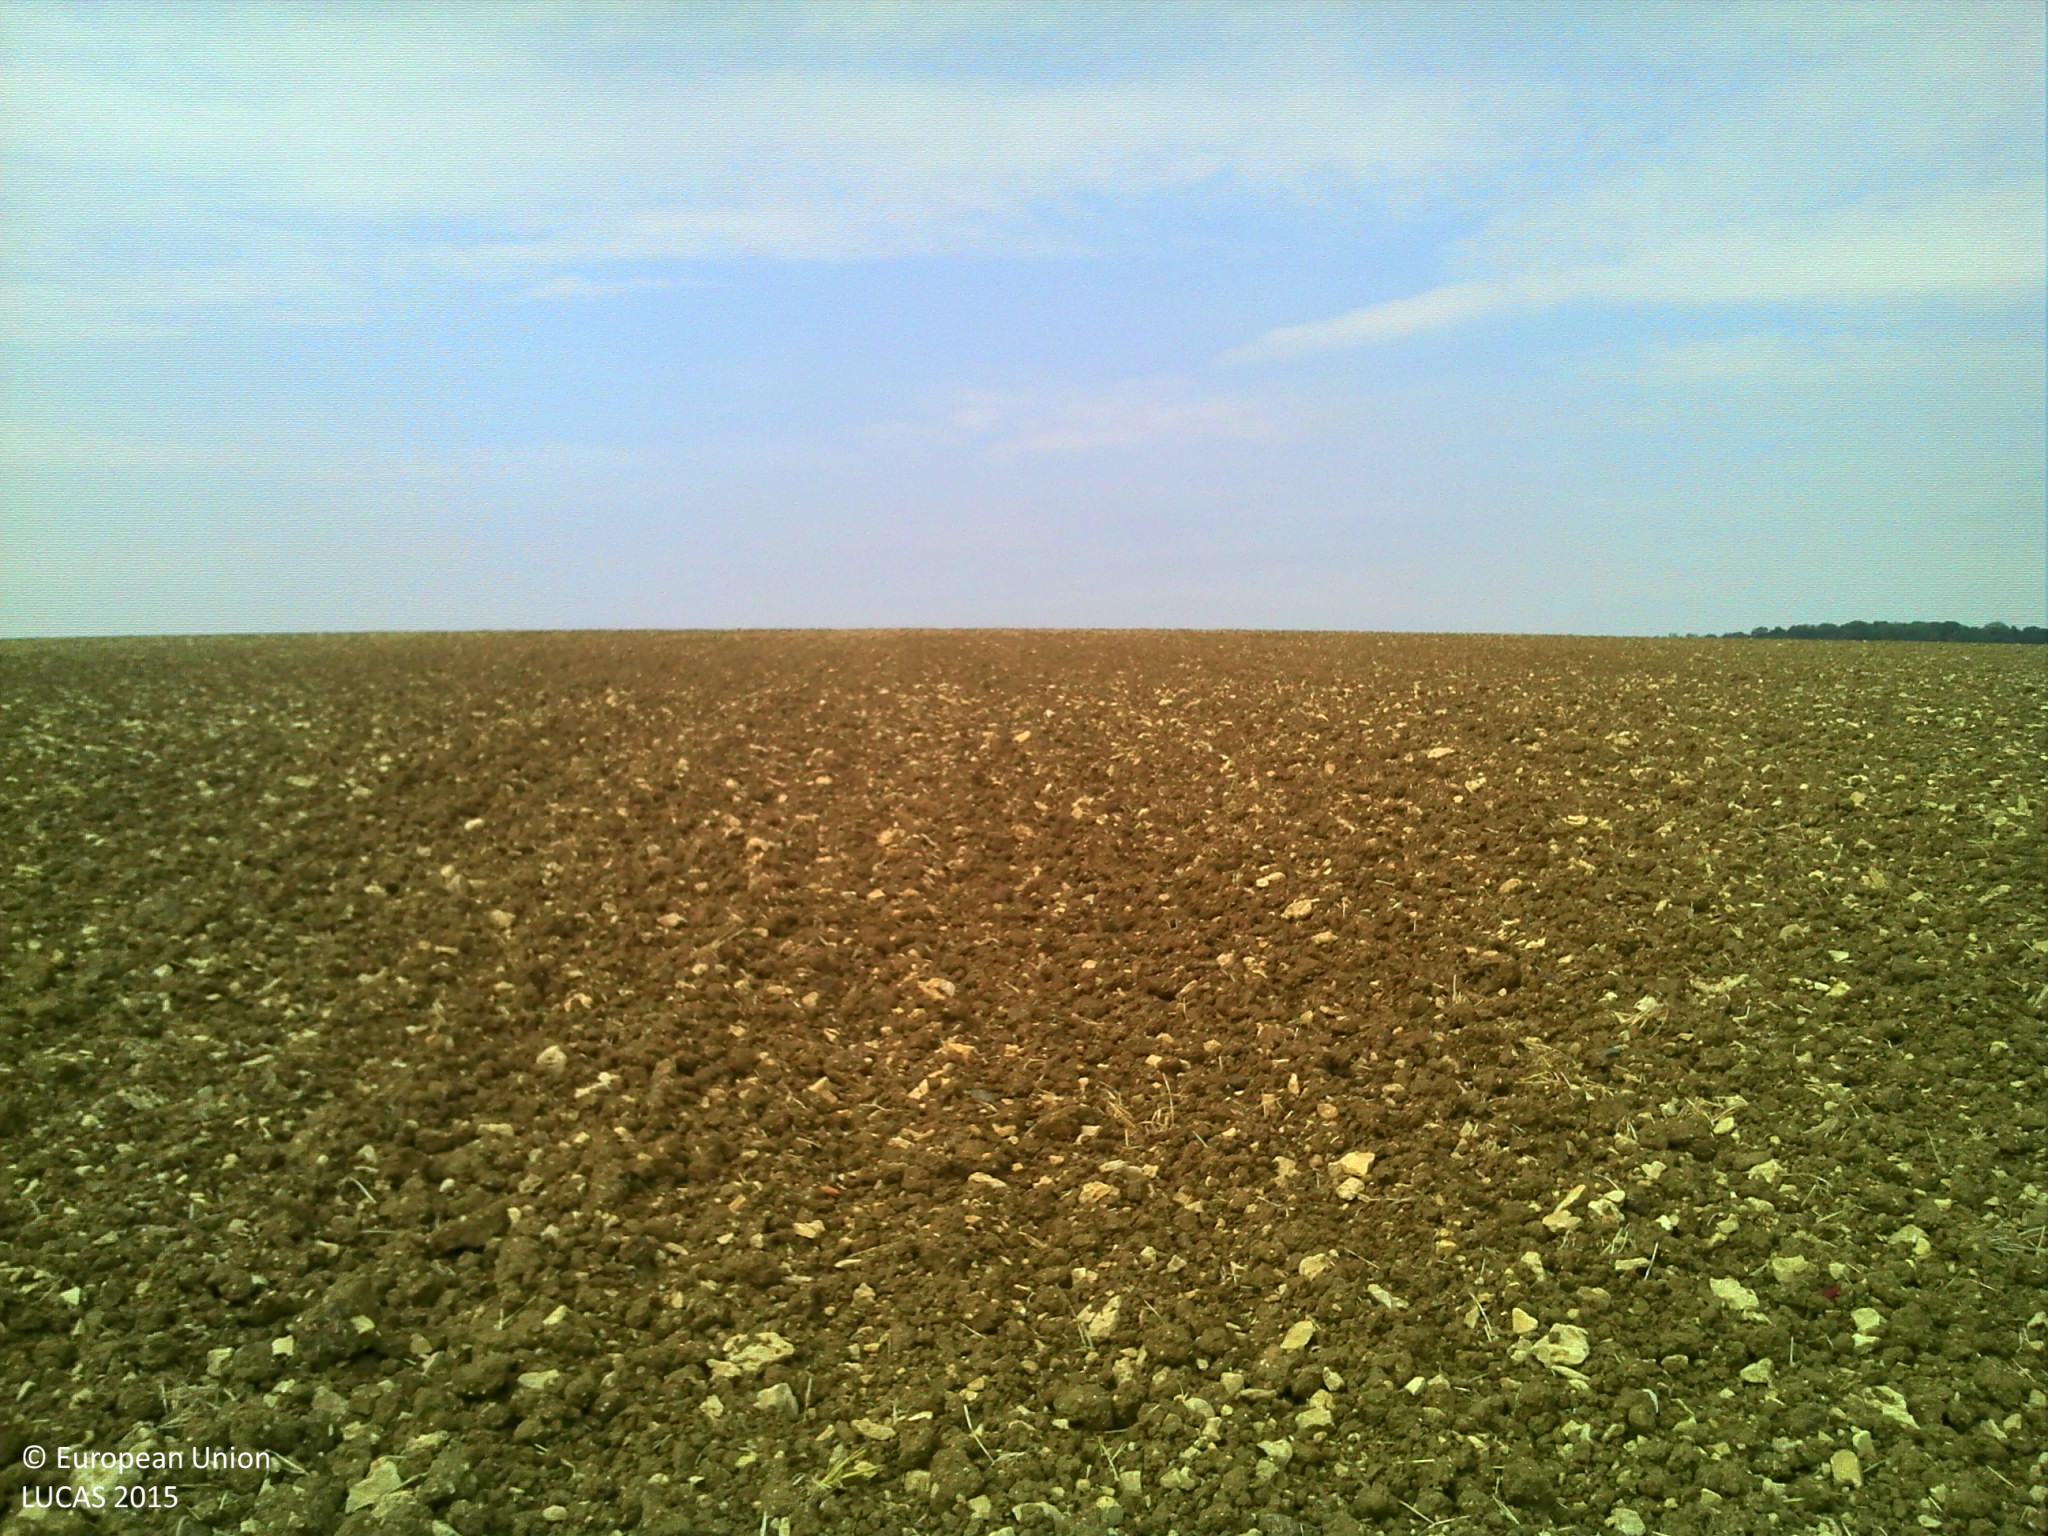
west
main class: Cropland
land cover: Barley
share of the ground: < 10 %
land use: Agriculture (excluding fallow land and kitchen gardens)
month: August
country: FR
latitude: 49.3396
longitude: 5.0845
